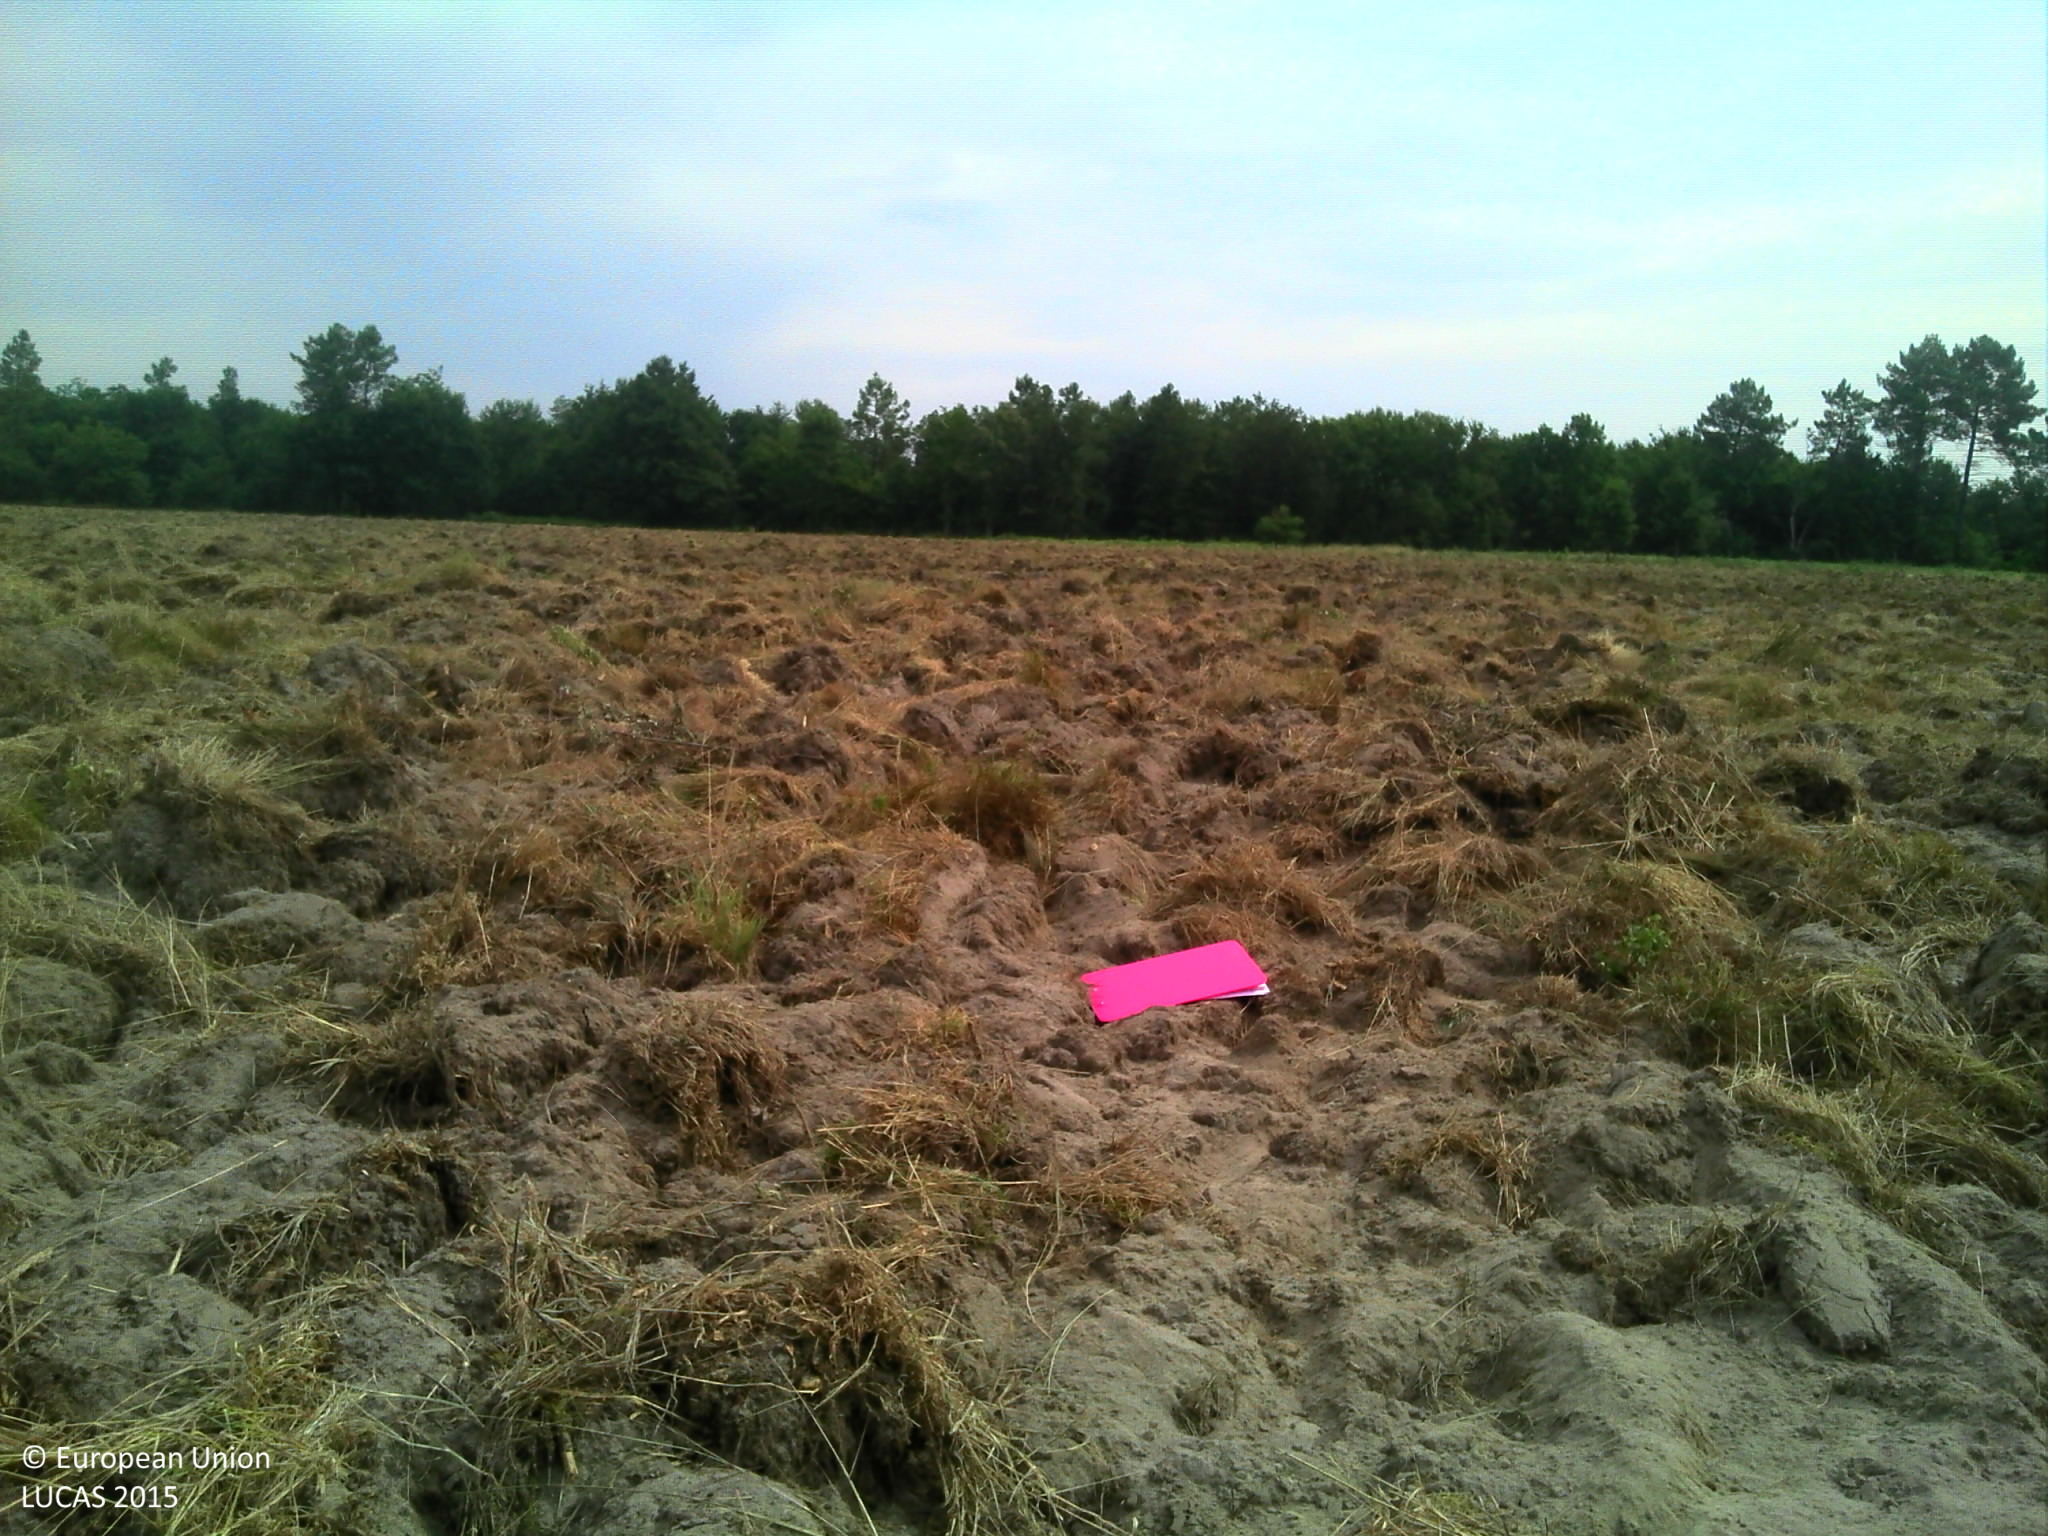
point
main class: Grassland
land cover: Spontaneously vegetated surfaces
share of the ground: 10 - 25 %
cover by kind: unconsolidated bare surface 80 %, herbaceous plants 20 %
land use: Forestry
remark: Tilled/Sowed
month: July
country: FR
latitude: 44.0848
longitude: -0.5415
